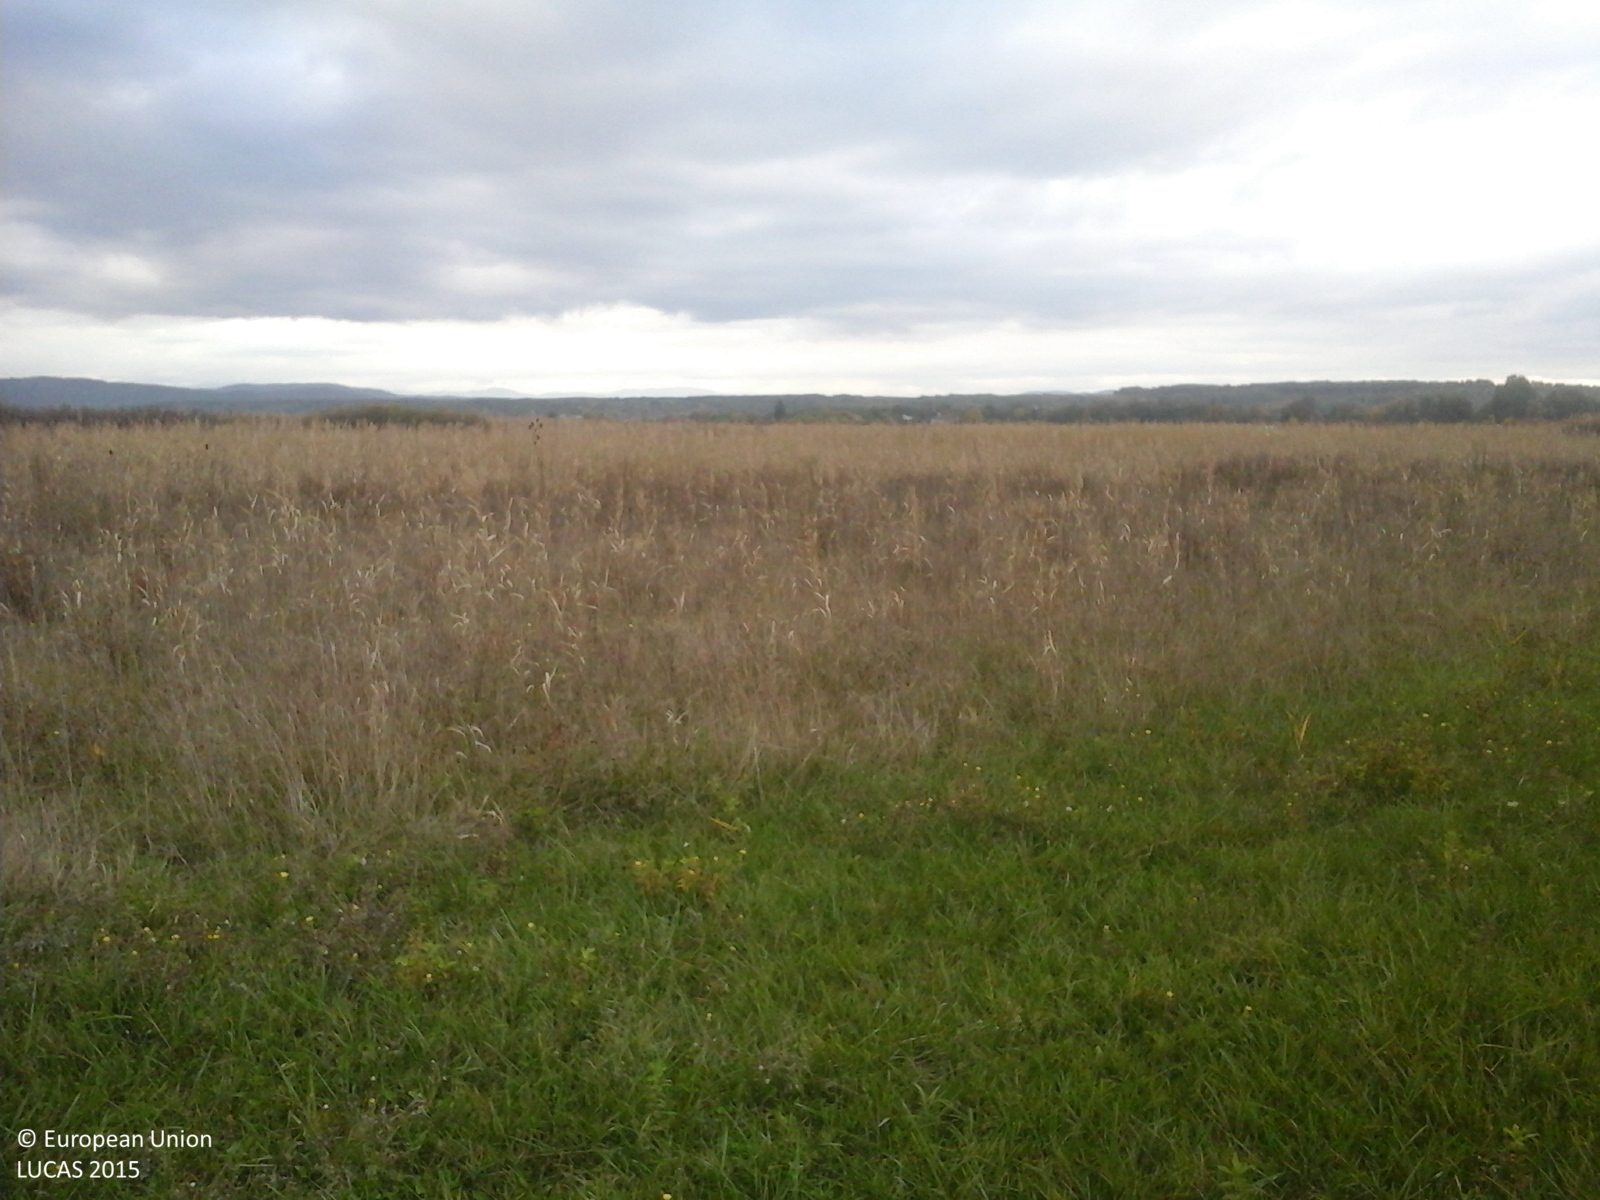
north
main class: Grassland
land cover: Grassland without tree/shrub cover
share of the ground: > 75 %
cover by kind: herbaceous plants 100 %
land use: Agriculture (excluding fallow land and kitchen gardens)
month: October
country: RO
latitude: 44.9025
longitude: 25.6121
